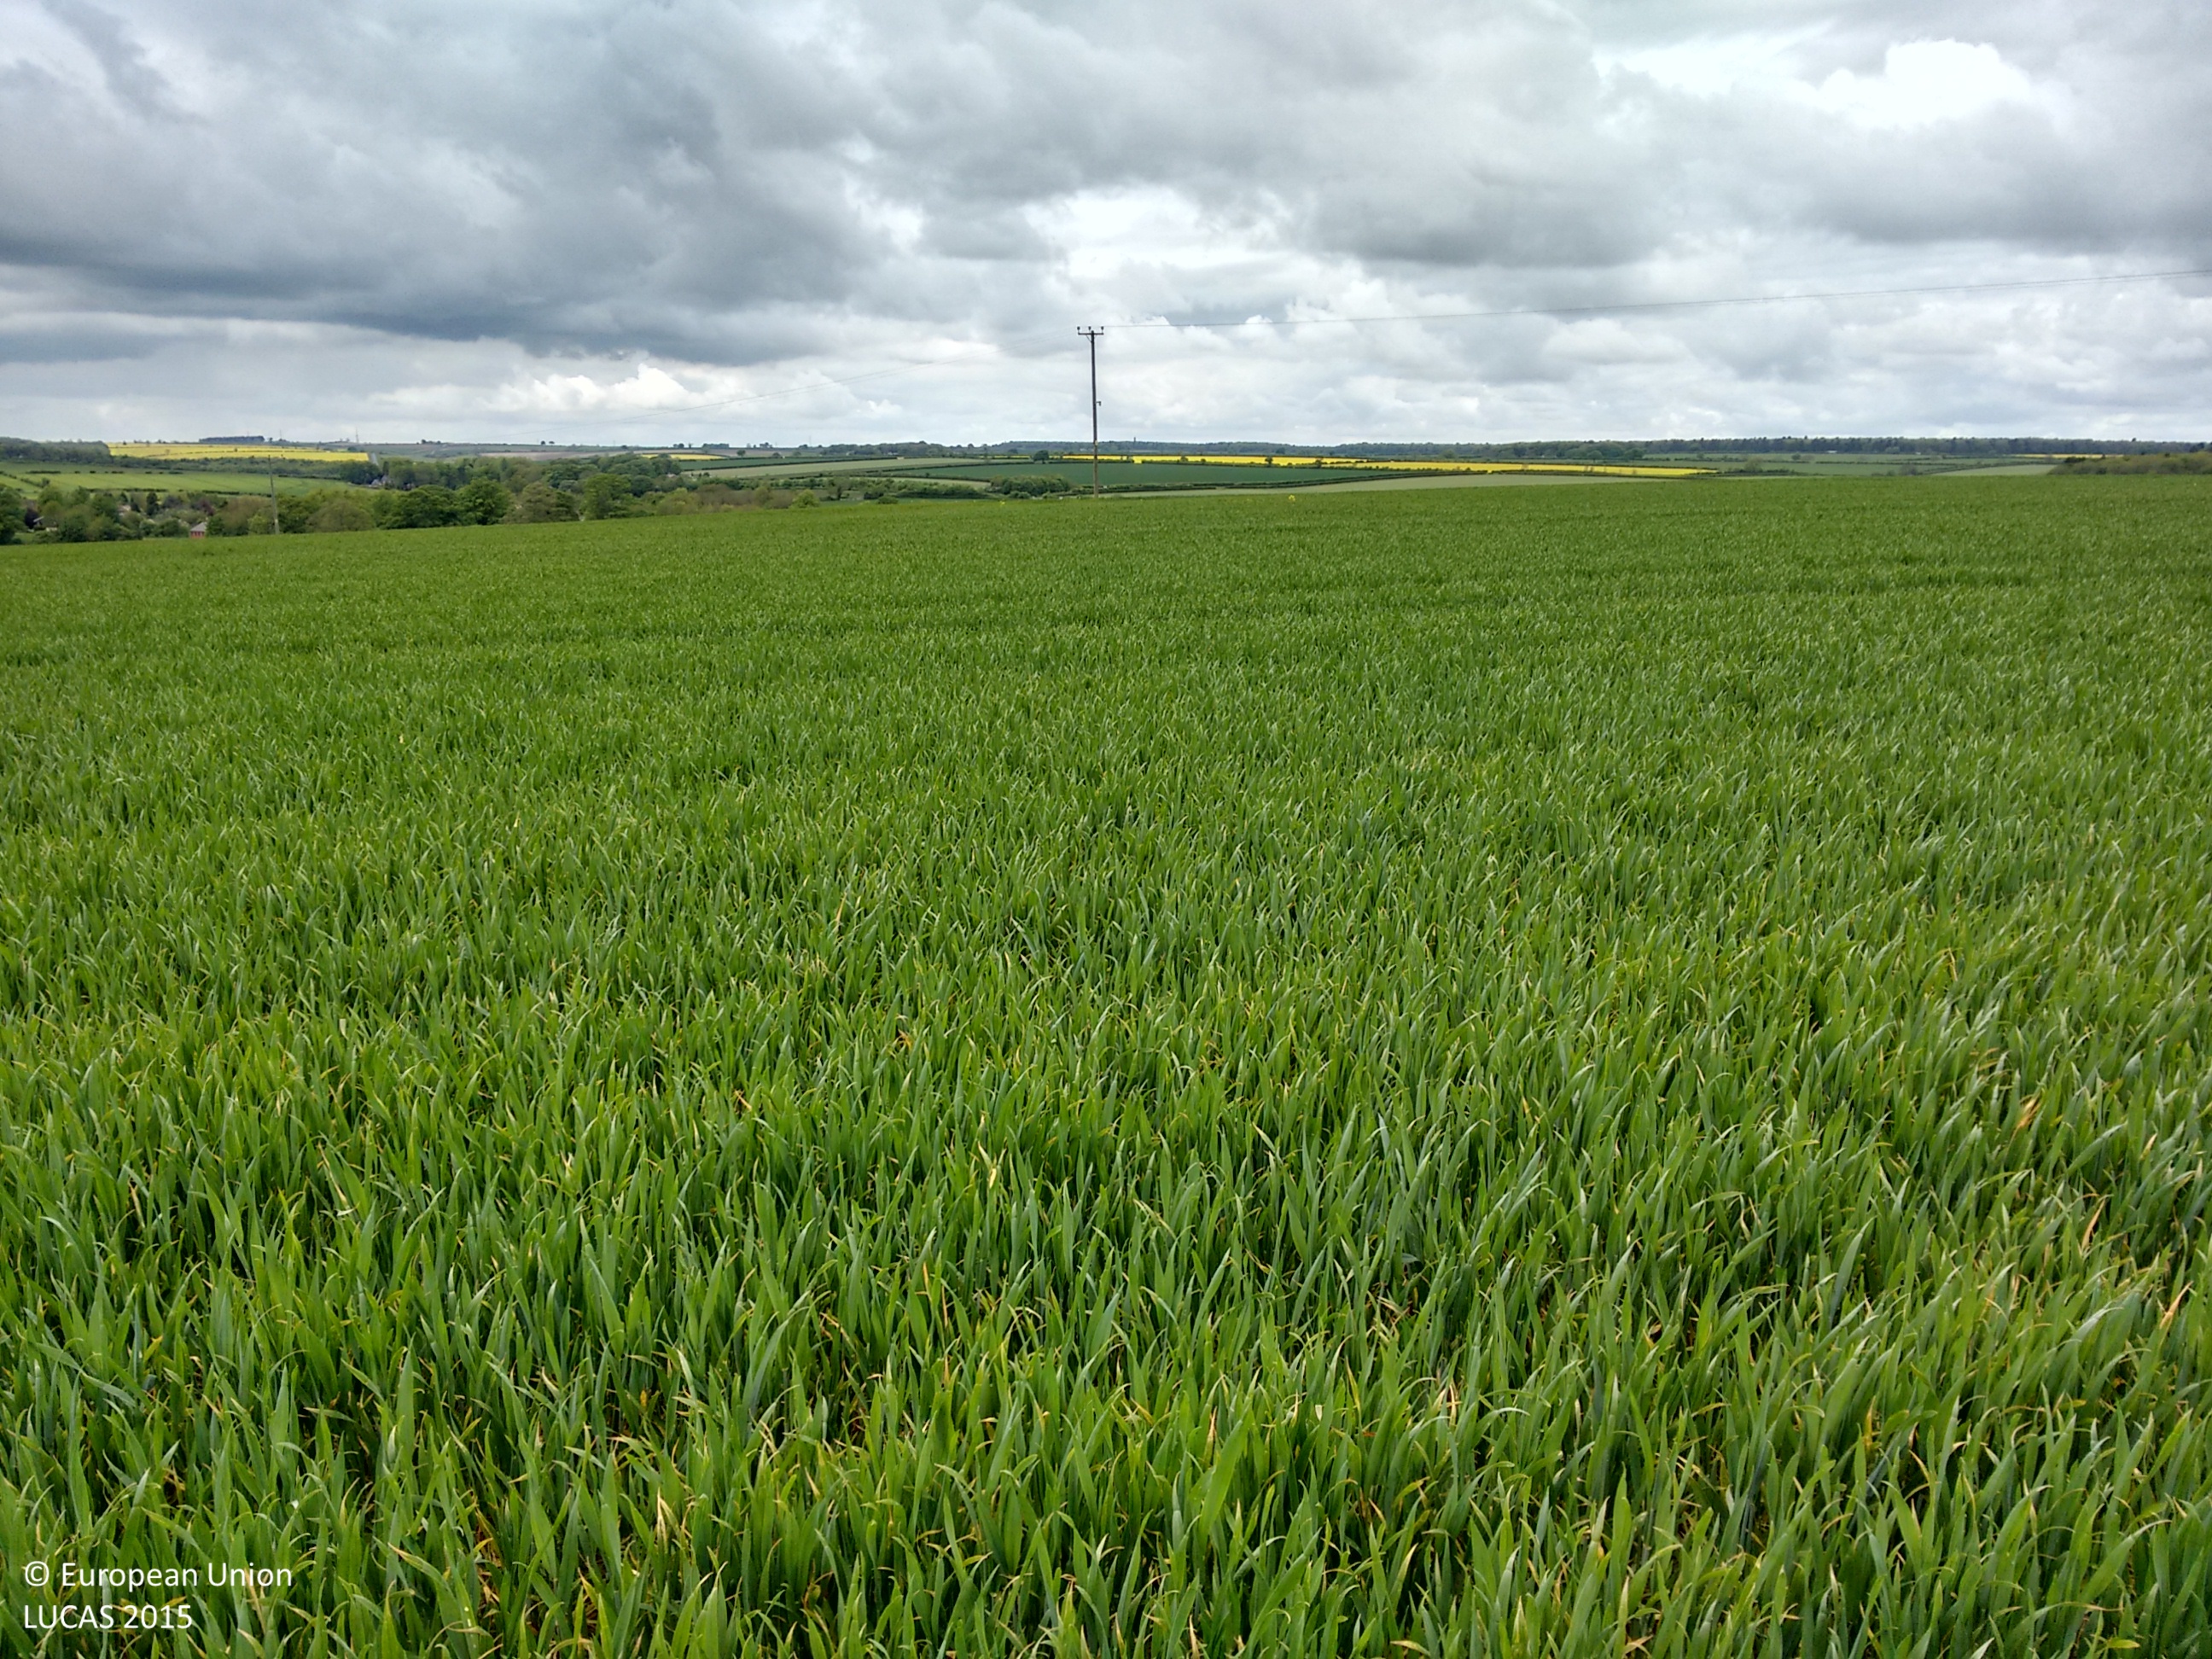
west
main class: Cropland
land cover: Common wheat
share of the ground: > 75 %
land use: Agriculture (excluding fallow land and kitchen gardens)
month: May
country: GB
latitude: 53.5128
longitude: -0.2130
